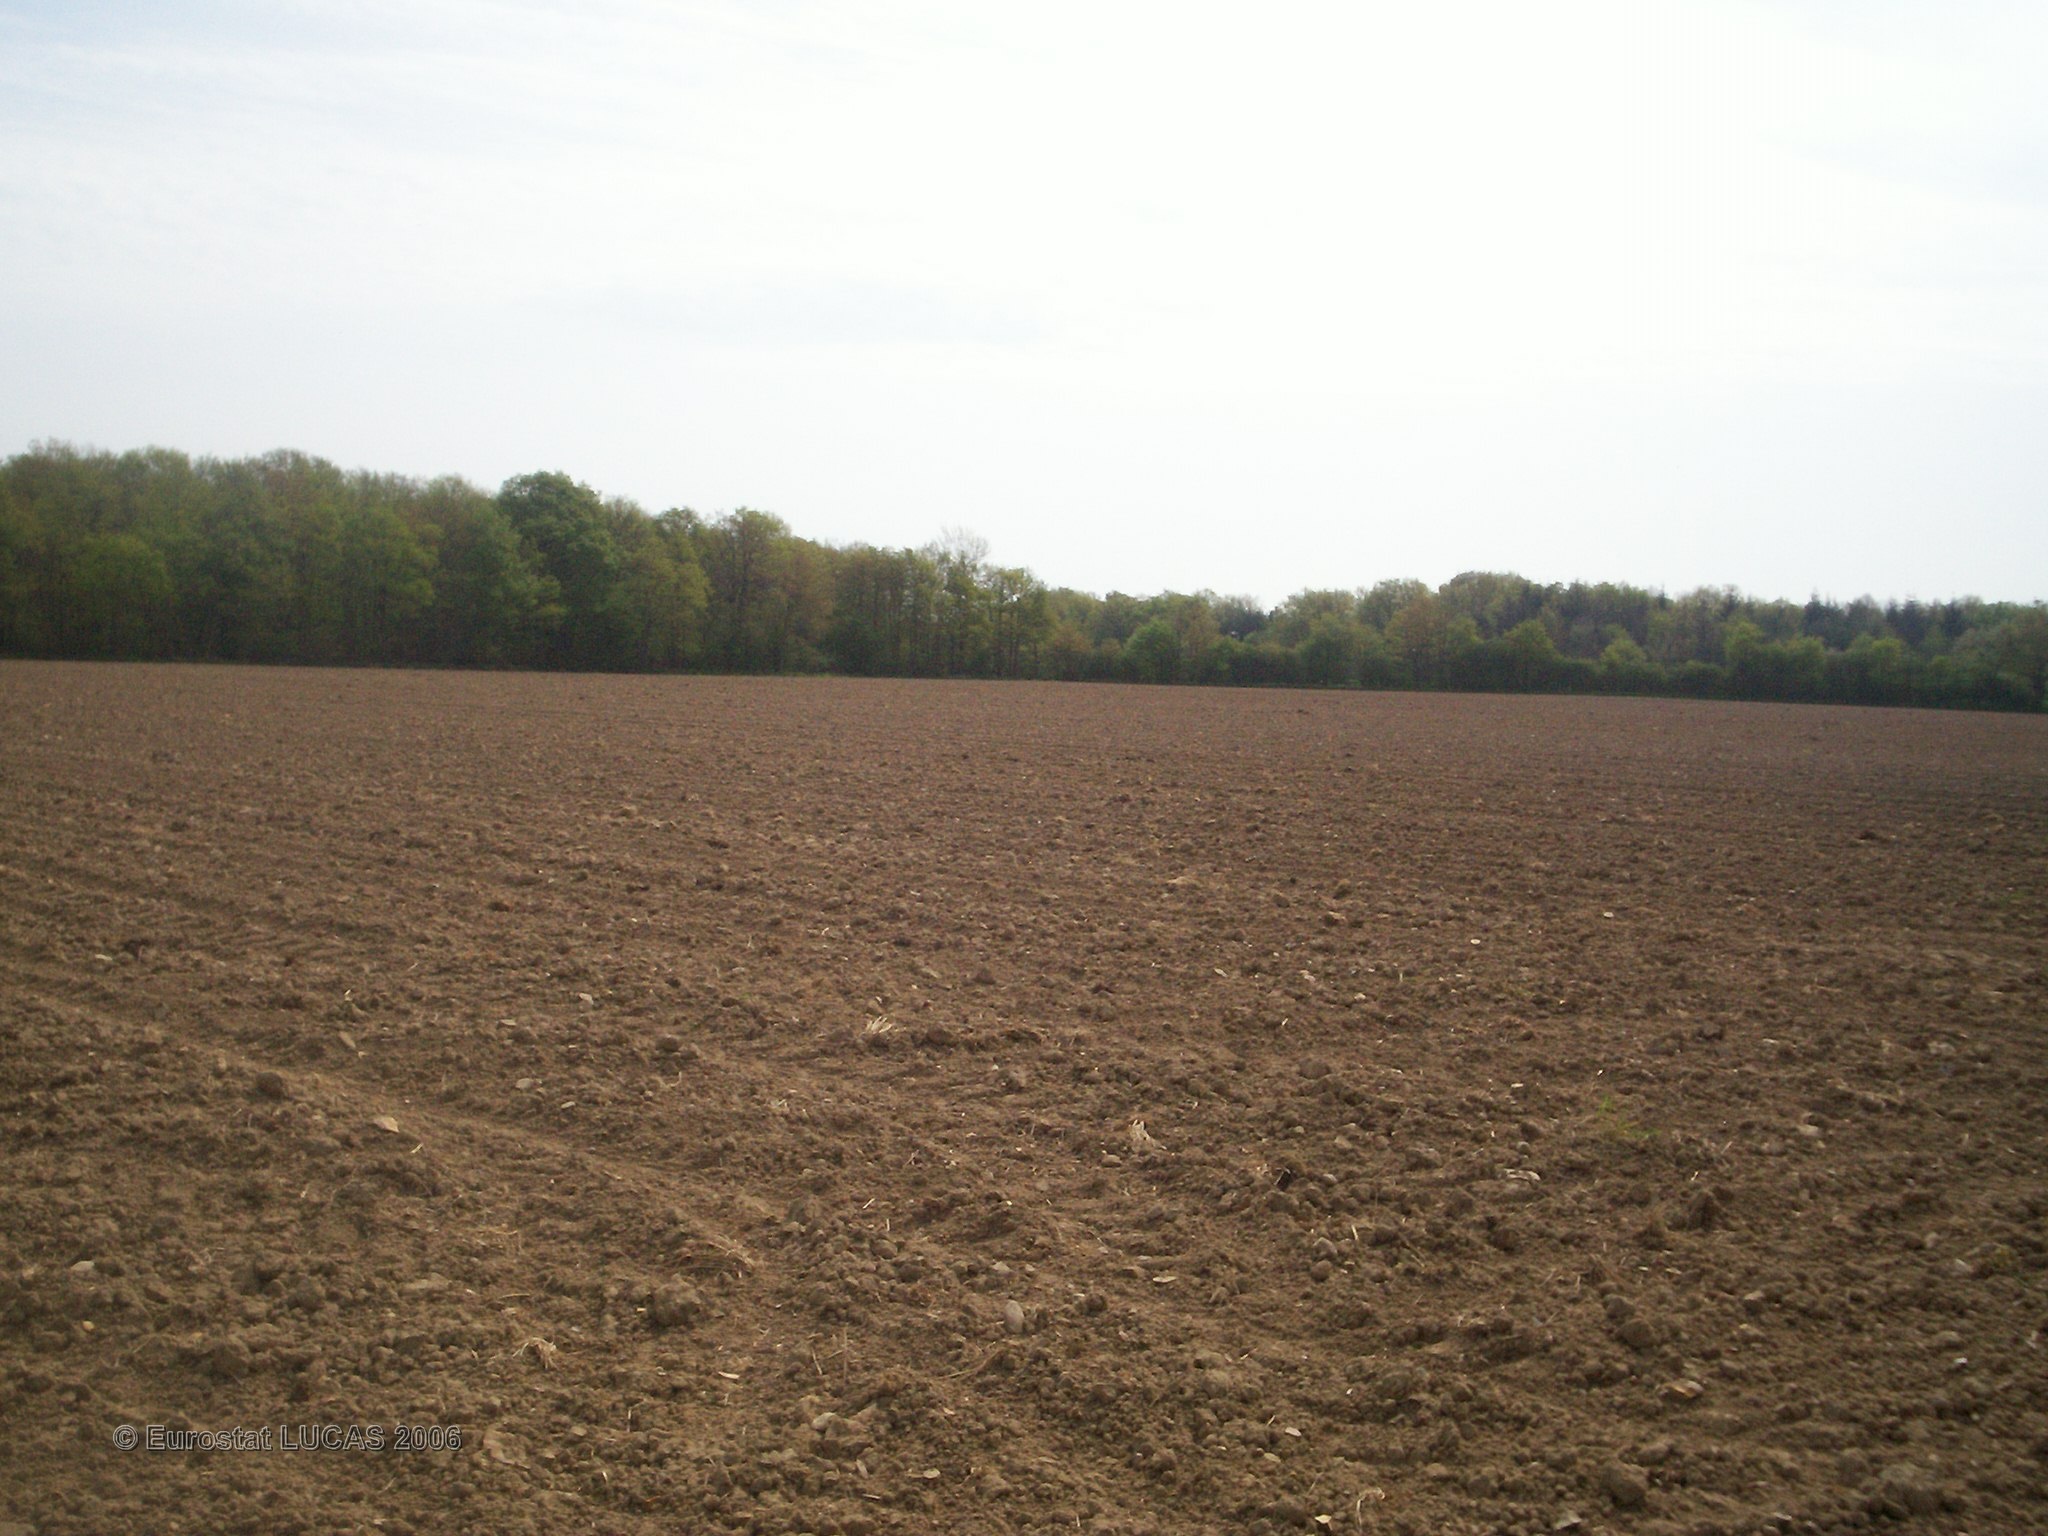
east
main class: Cropland
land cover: Maize
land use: Agriculture (excluding fallow land and kitchen gardens)
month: June
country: FR
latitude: 47.5991
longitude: 2.9313
